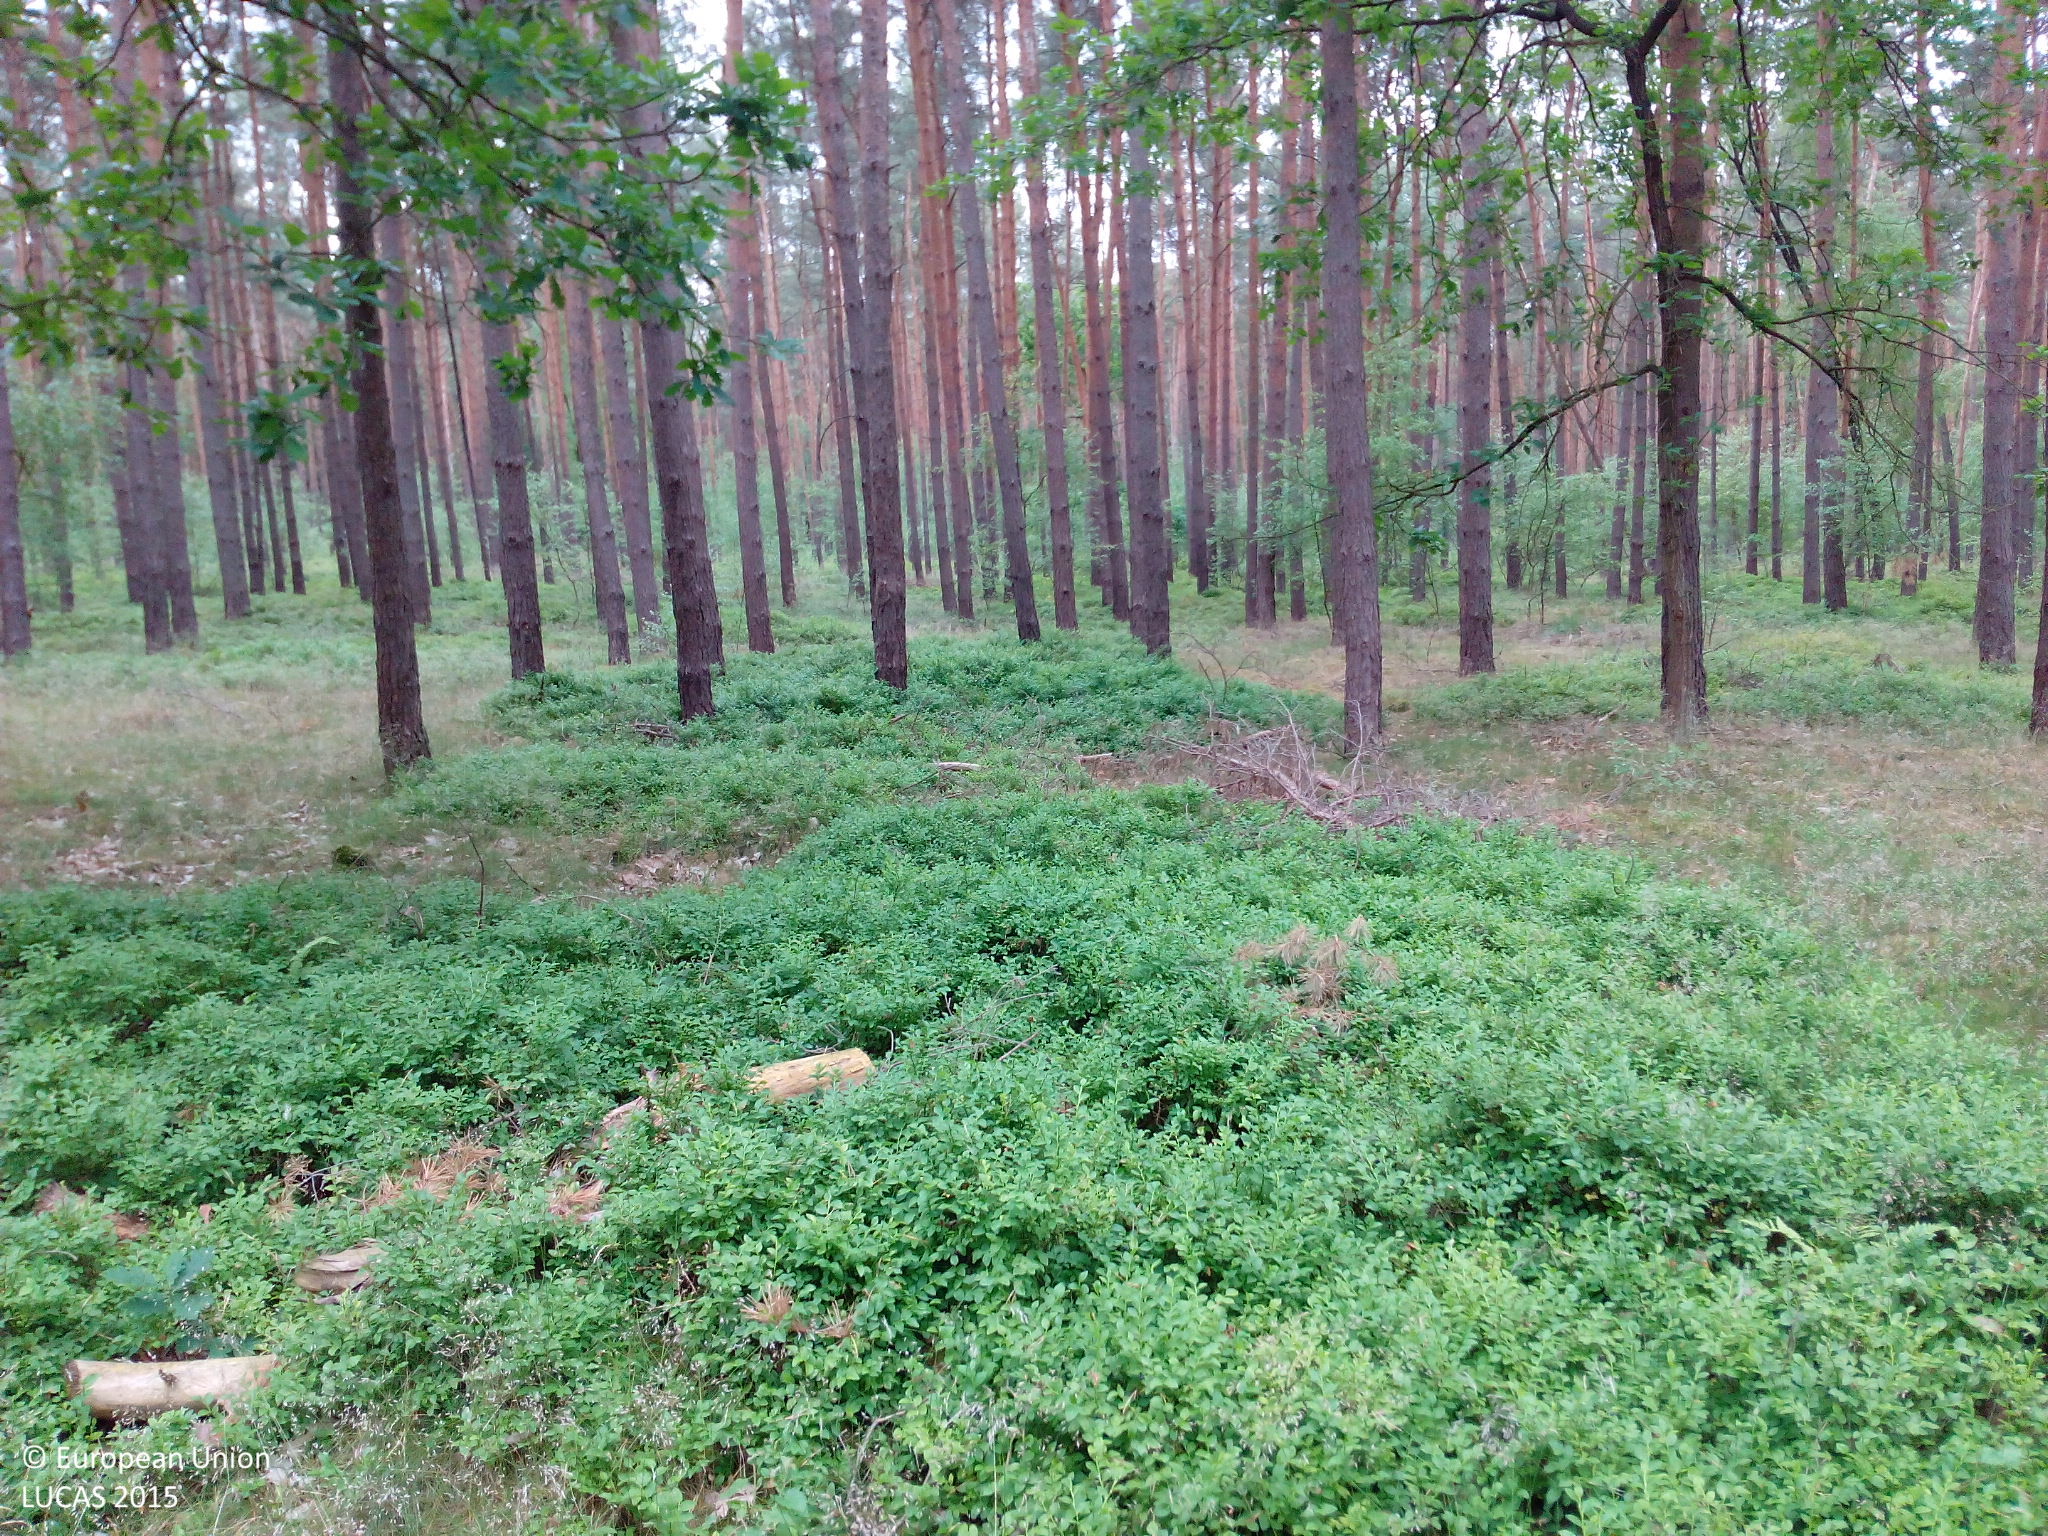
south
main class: Woodland
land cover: Pine dominated coniferous woodland
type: hemiboreal forest and nemoral coniferous forest and mixed broadleaved-coniferous forest
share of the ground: 50 - 75 %
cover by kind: coniferous forest trees 50 %, herbaceous plants 20 %, broadleaved forest trees 10 %, shrubs 10 %, lichens and mosses 10 %
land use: Forestry
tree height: > 5 m
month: June
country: DE
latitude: 52.5689
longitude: 12.4044
